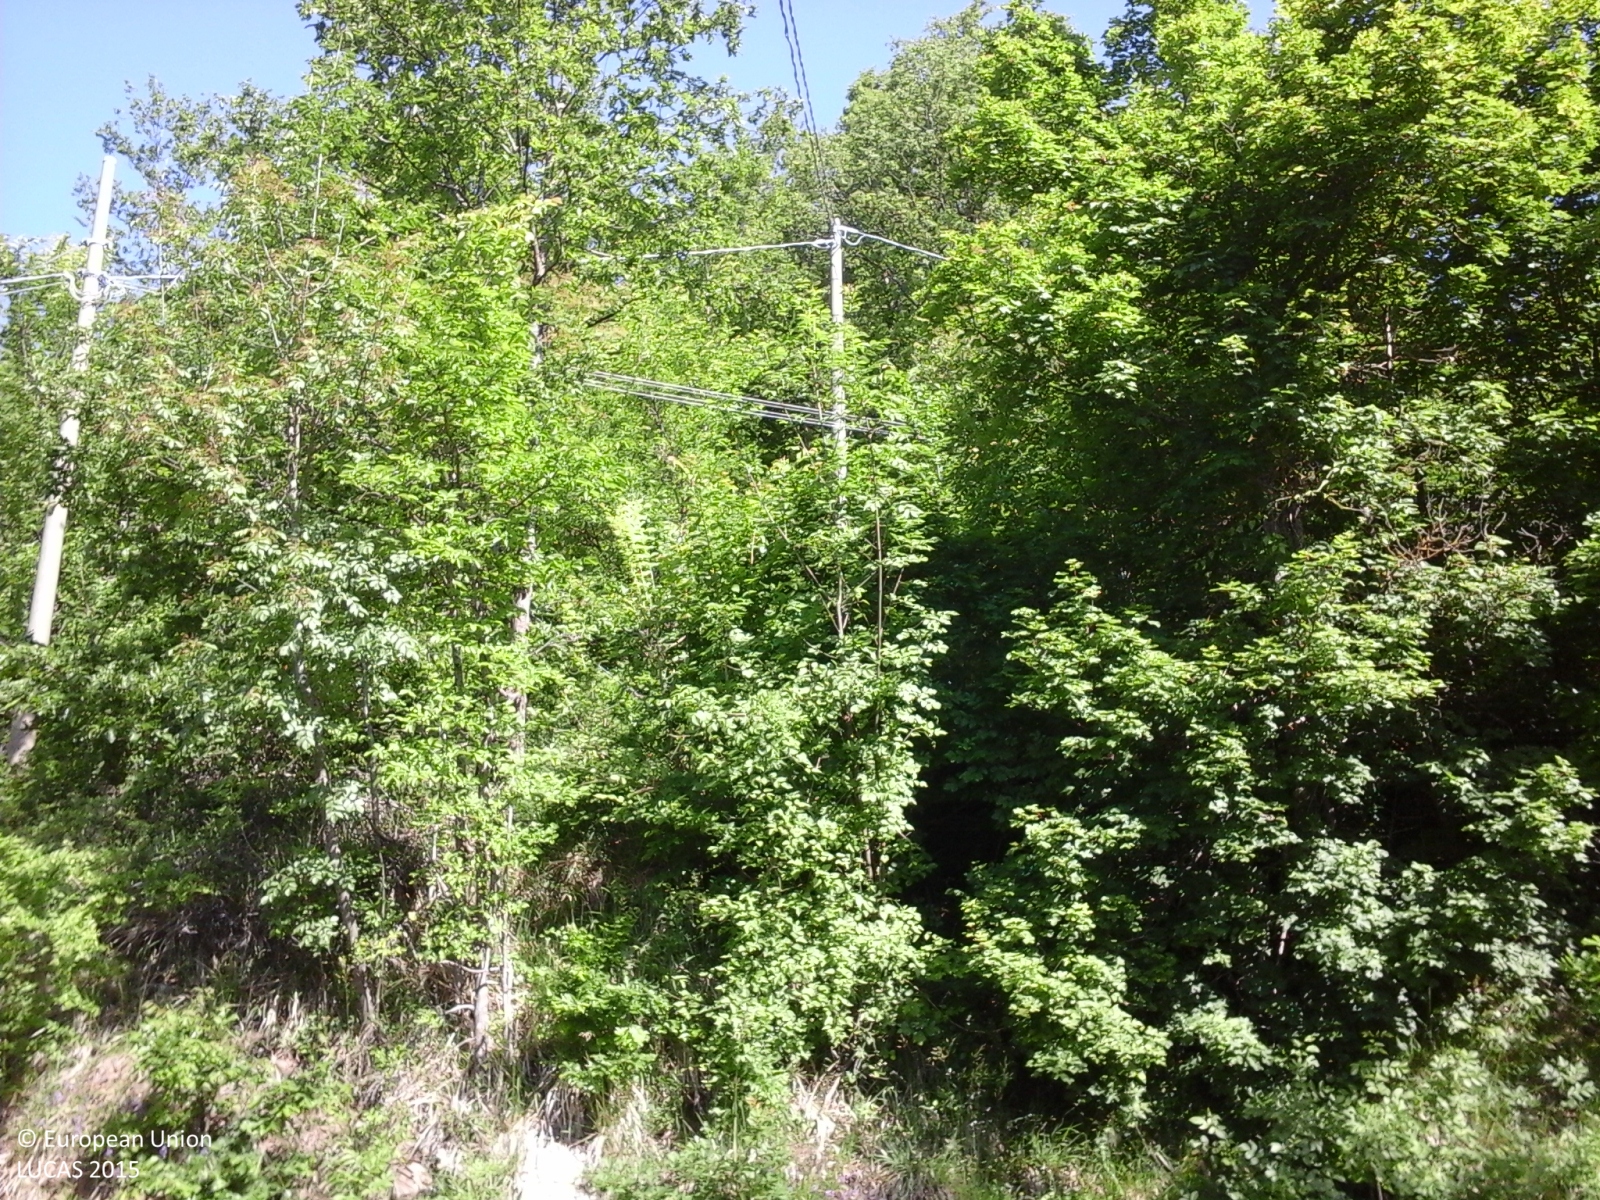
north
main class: Woodland
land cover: Broadleaved woodland
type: thermophilous deciduous forest
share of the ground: > 75 %
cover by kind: broadleaved forest trees 95 %, shrubs 5 %
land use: Forestry
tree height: > 5 m
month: May
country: IT
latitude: 44.5121
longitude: 9.6109
